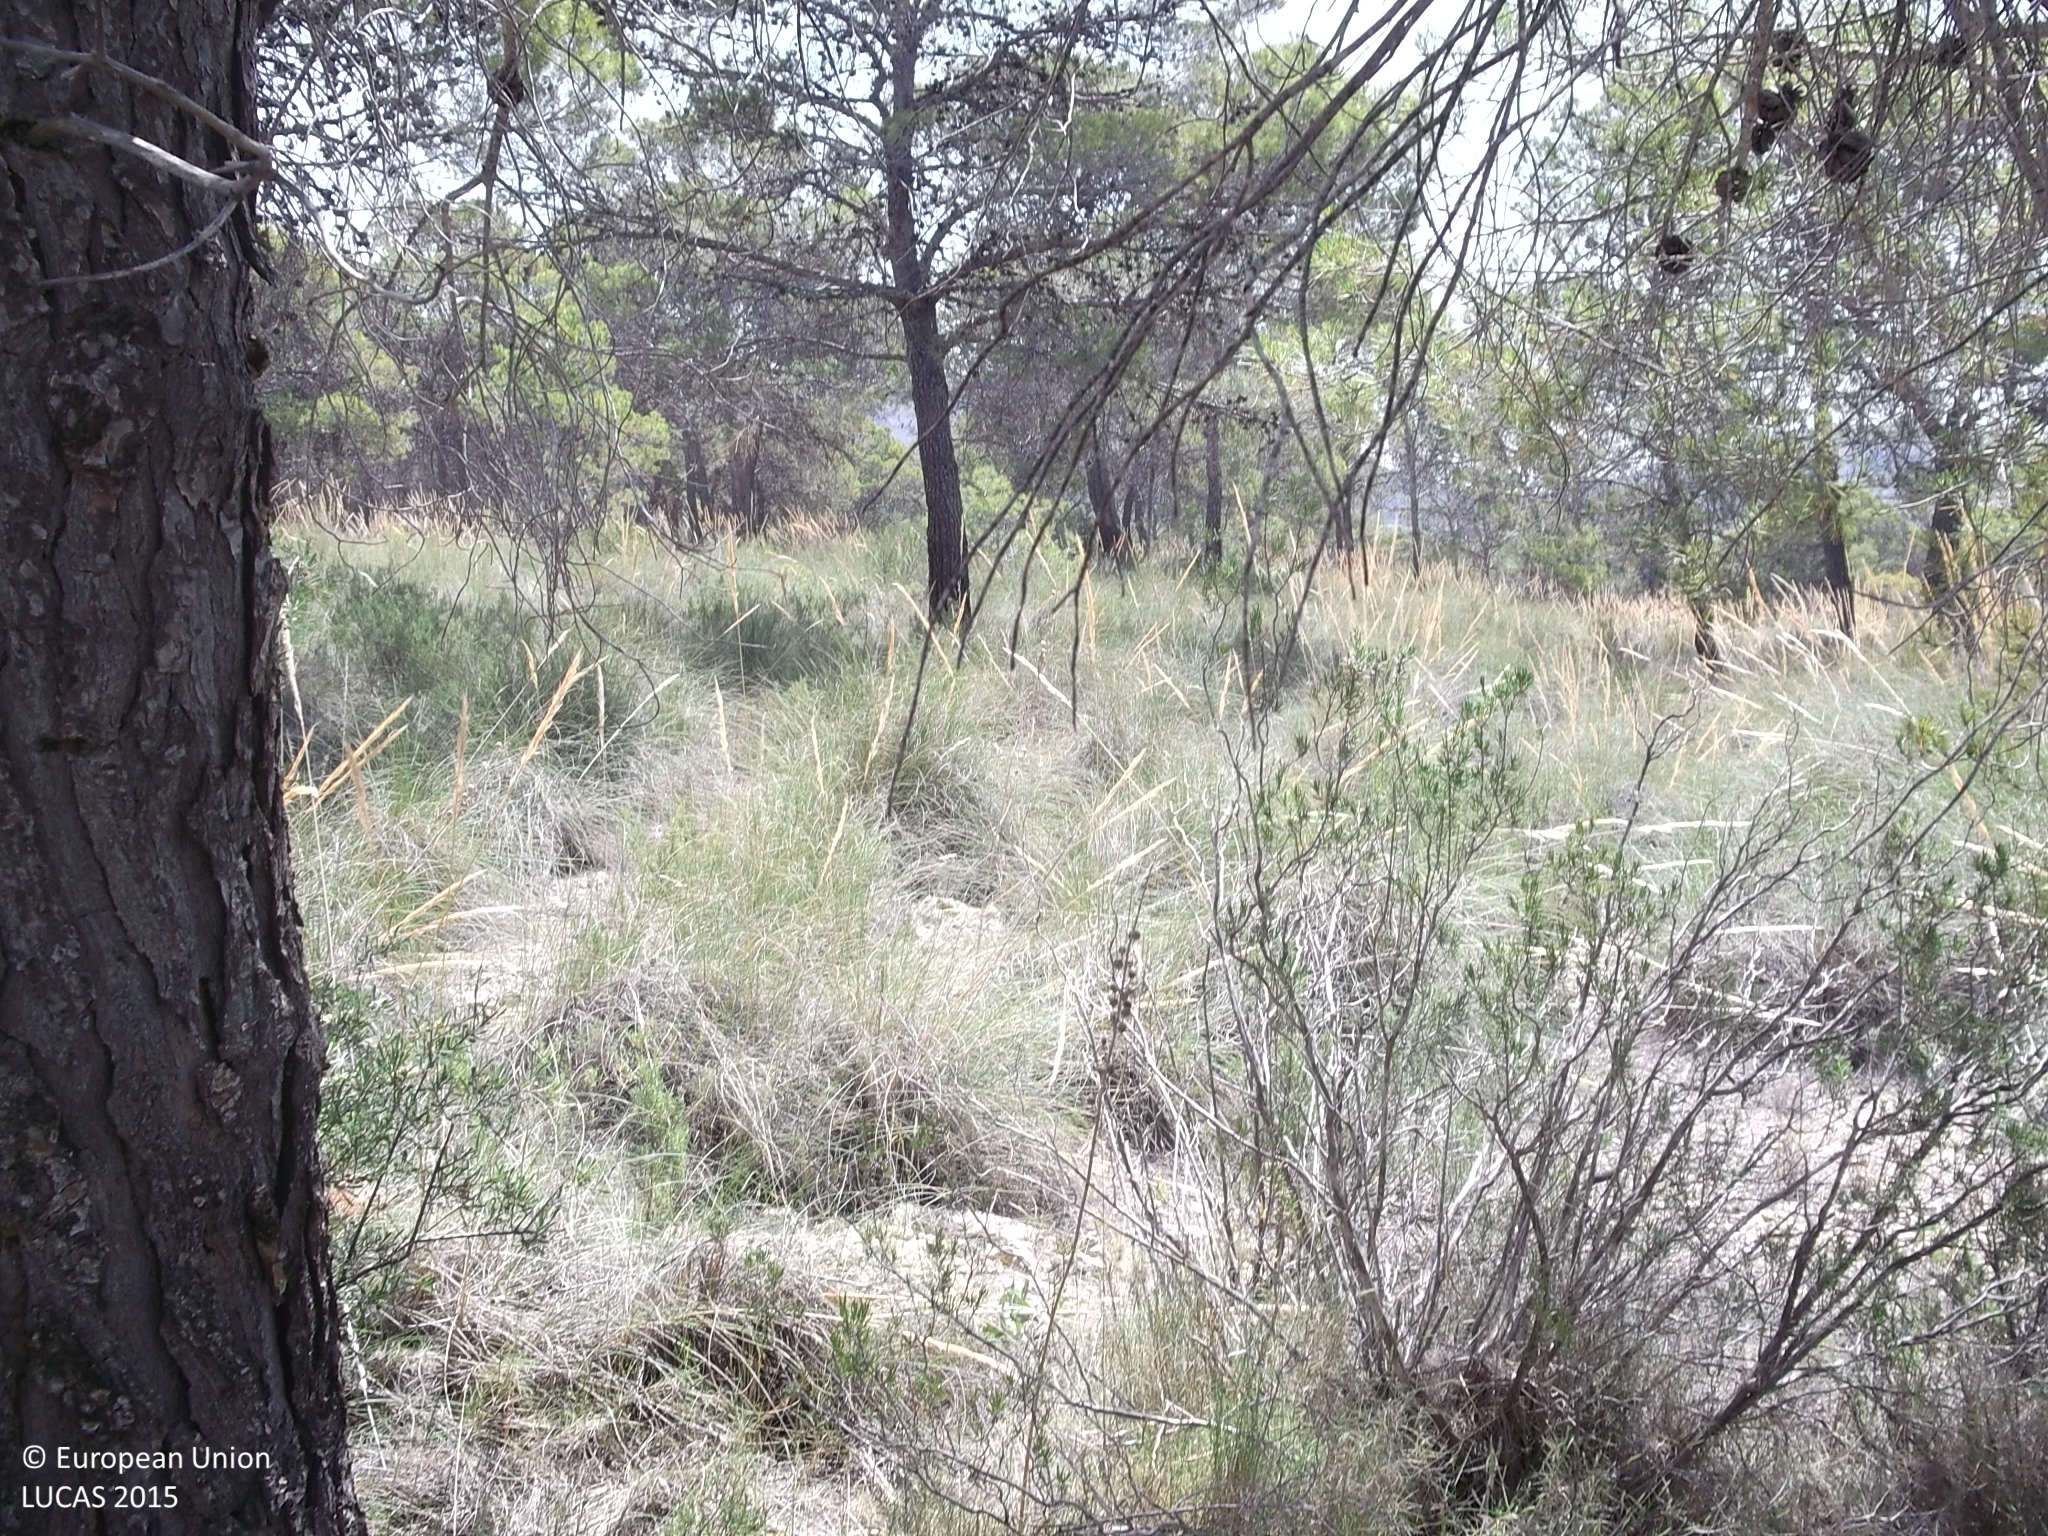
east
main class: Woodland
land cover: Pine dominated coniferous woodland
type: coniferous forest of the mediterranean region
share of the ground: 25 - 50 %
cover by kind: shrubs 35 %, coniferous forest trees 25 %, herbaceous plants 20 %, consolidated bare surface 20 %
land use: Semi-natural and natural areas not in use
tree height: > 5 m
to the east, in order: Pine dominated coniferous woodland; Tracks; Pine dominated coniferous woodland; Tracks; Shrubland without tree cover; Nuts trees
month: June
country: ES
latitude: 38.4023
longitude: -1.3378
